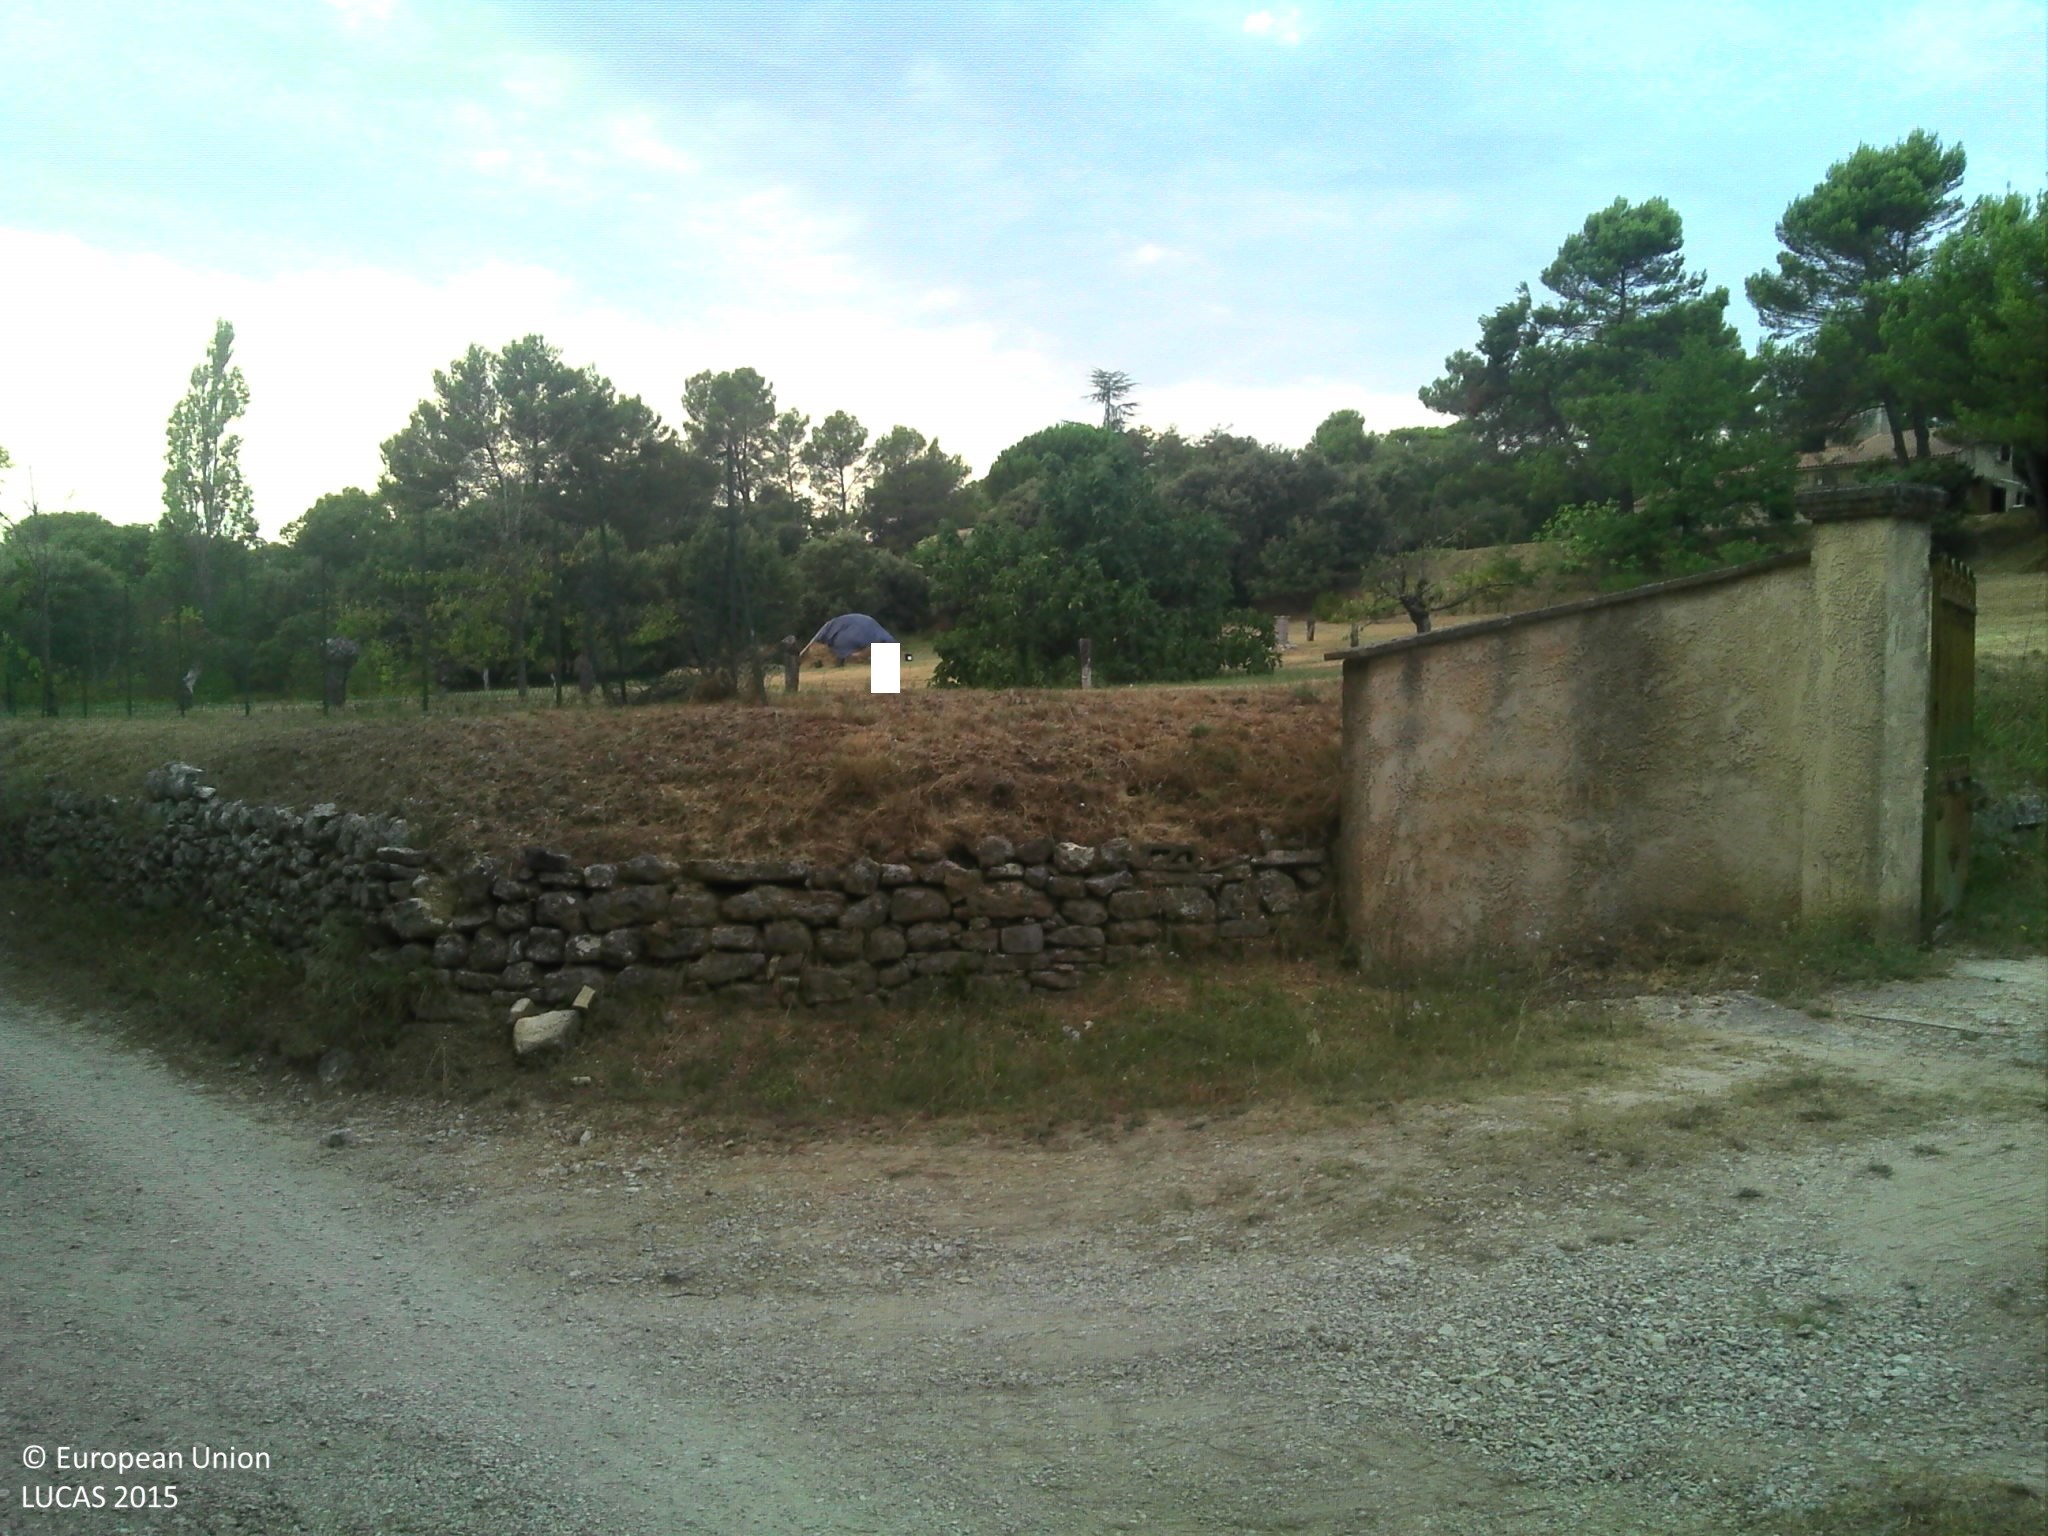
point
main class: Grassland
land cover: Grassland with sparse tree/shrub cover
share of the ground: > 75 %
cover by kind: herbaceous plants 95 %, broadleaved forest trees 5 %
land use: Residential
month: August
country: FR
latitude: 43.6517
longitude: 5.3847
